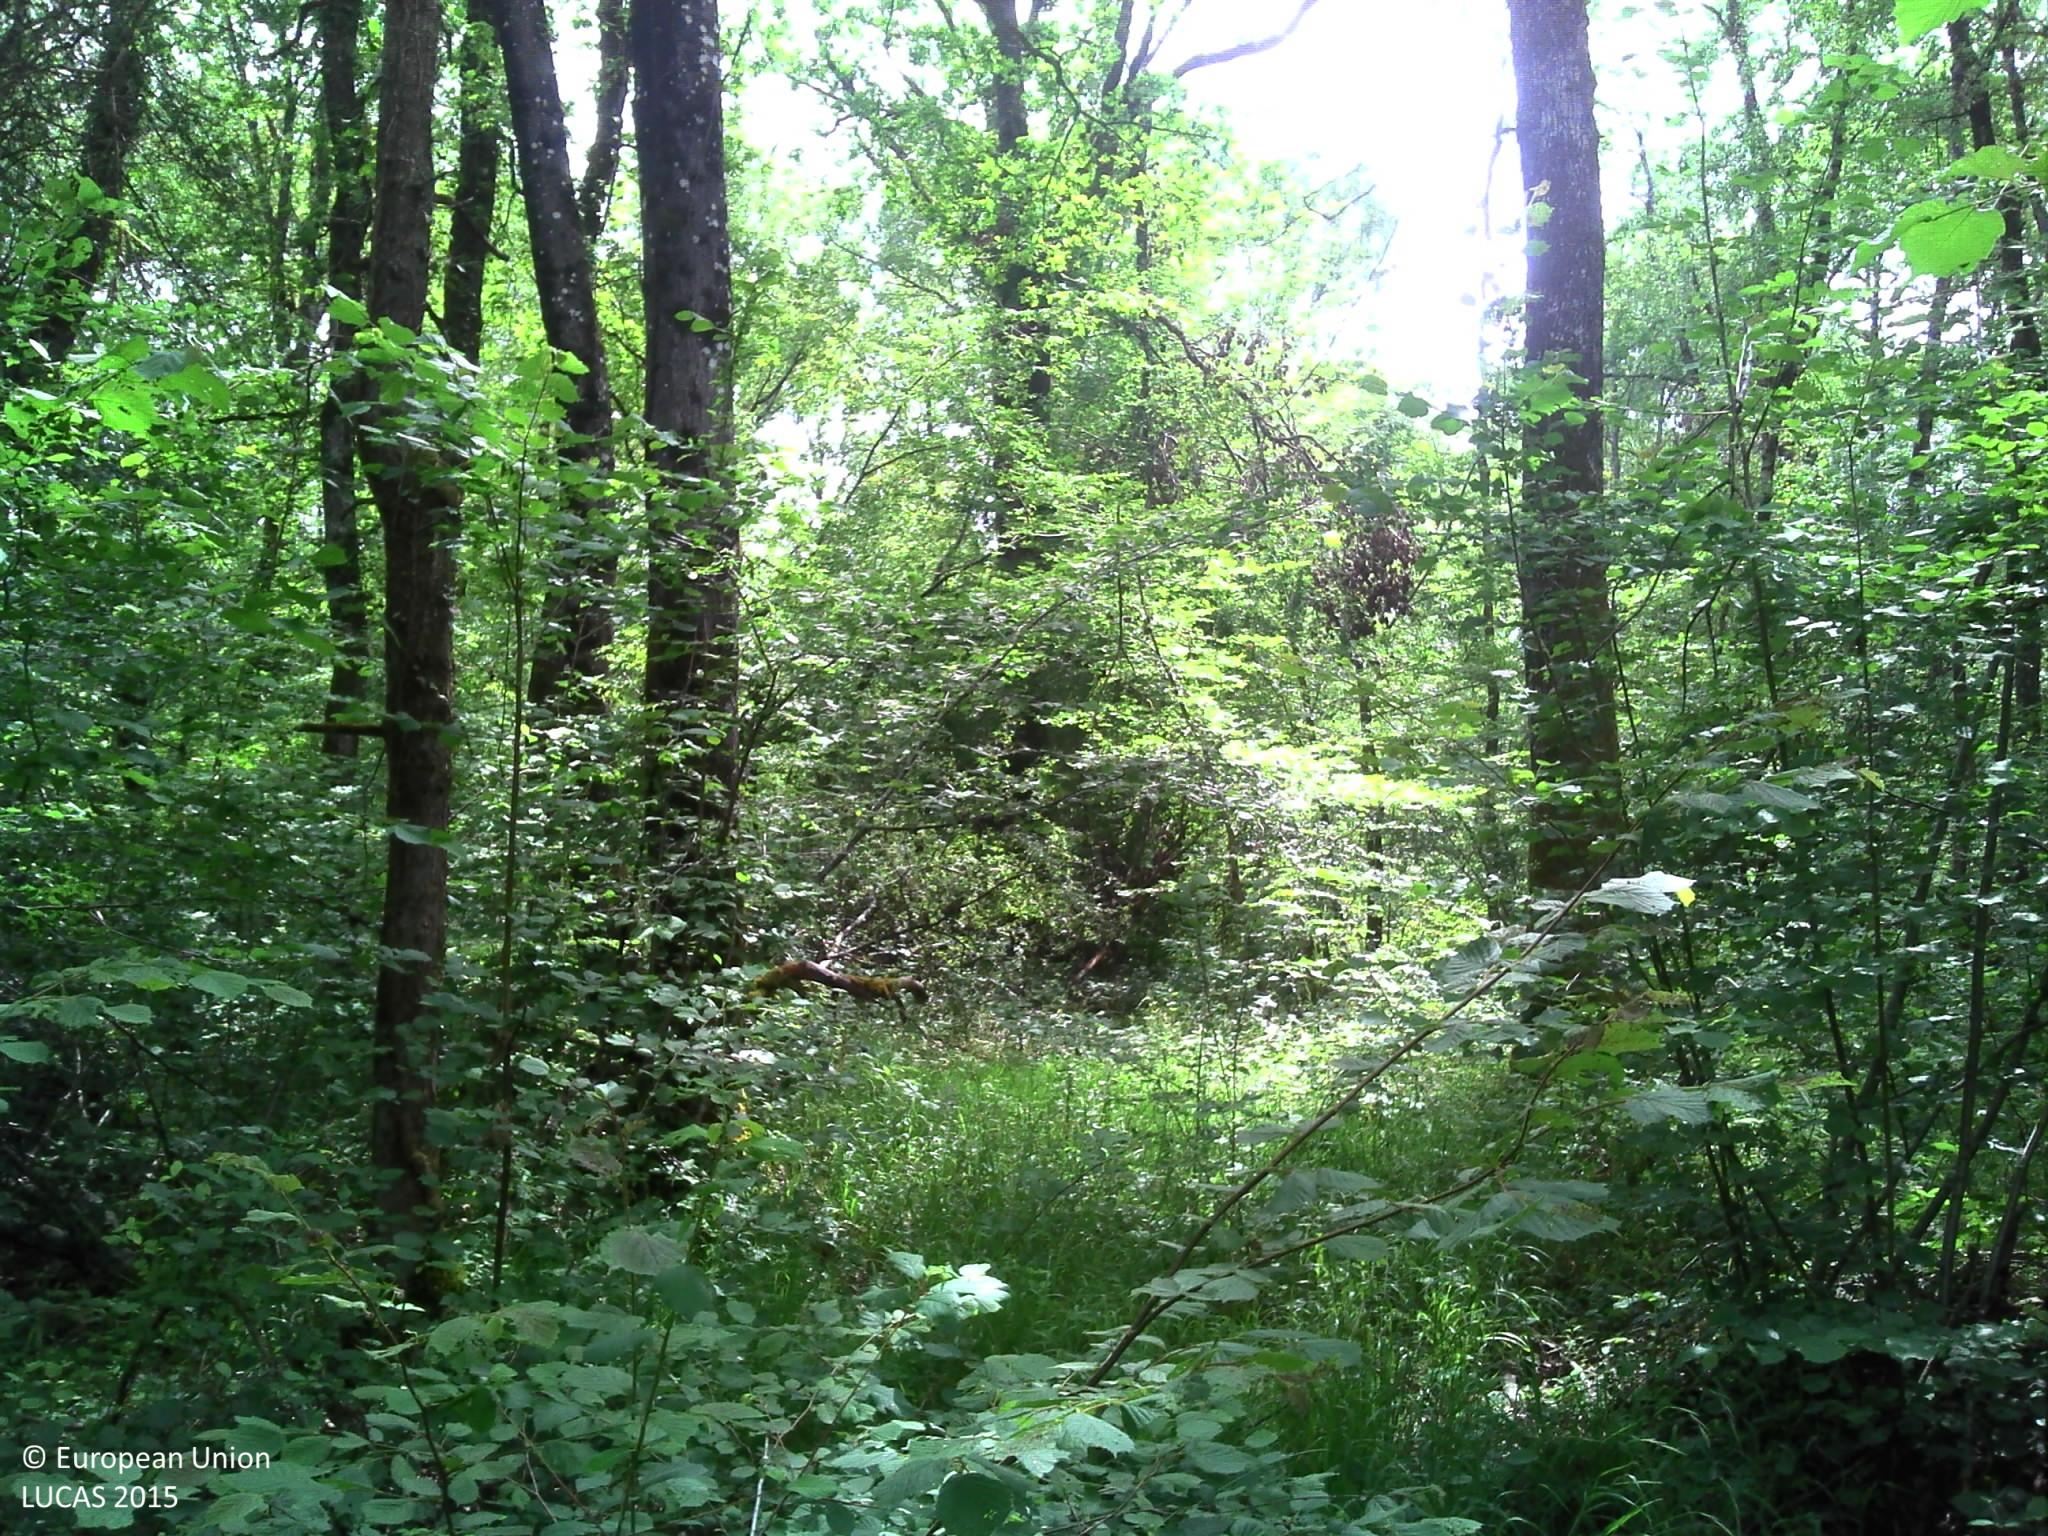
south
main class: Woodland
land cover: Broadleaved woodland
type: mesophytic deciduous forest
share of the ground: > 75 %
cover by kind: broadleaved forest trees 95 %, herbaceous plants 5 %
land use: Forestry
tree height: > 5 m
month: June
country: FR
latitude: 47.1139
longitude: 2.9707
